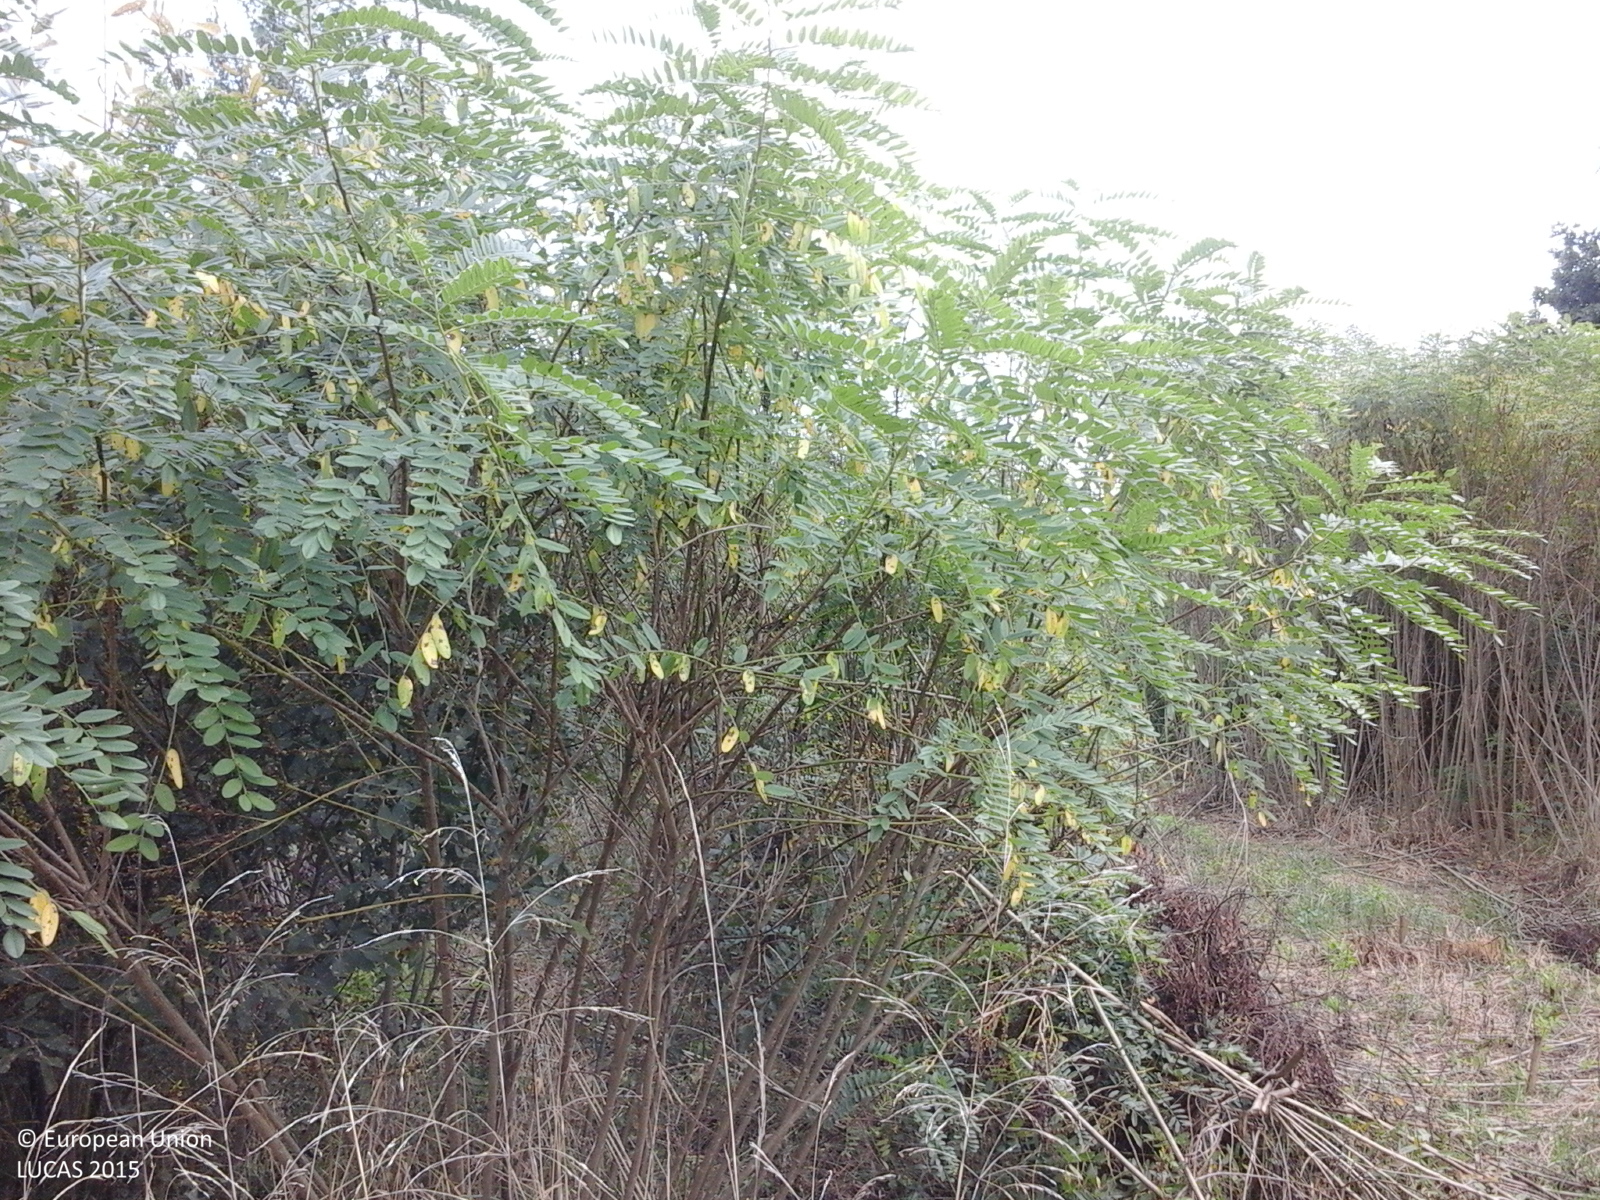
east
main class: Shrubland
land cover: Shrubland without tree cover
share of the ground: > 75 %
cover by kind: shrubs 100 %
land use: Semi-natural and natural areas not in use
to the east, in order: Shrubland without tree cover; Spontaneously vegetated surfaces; Shrubland without tree cover; Grassland without tree/shrub cover; Broadleaved woodland
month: September
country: RO
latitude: 45.9788
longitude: 22.1899
